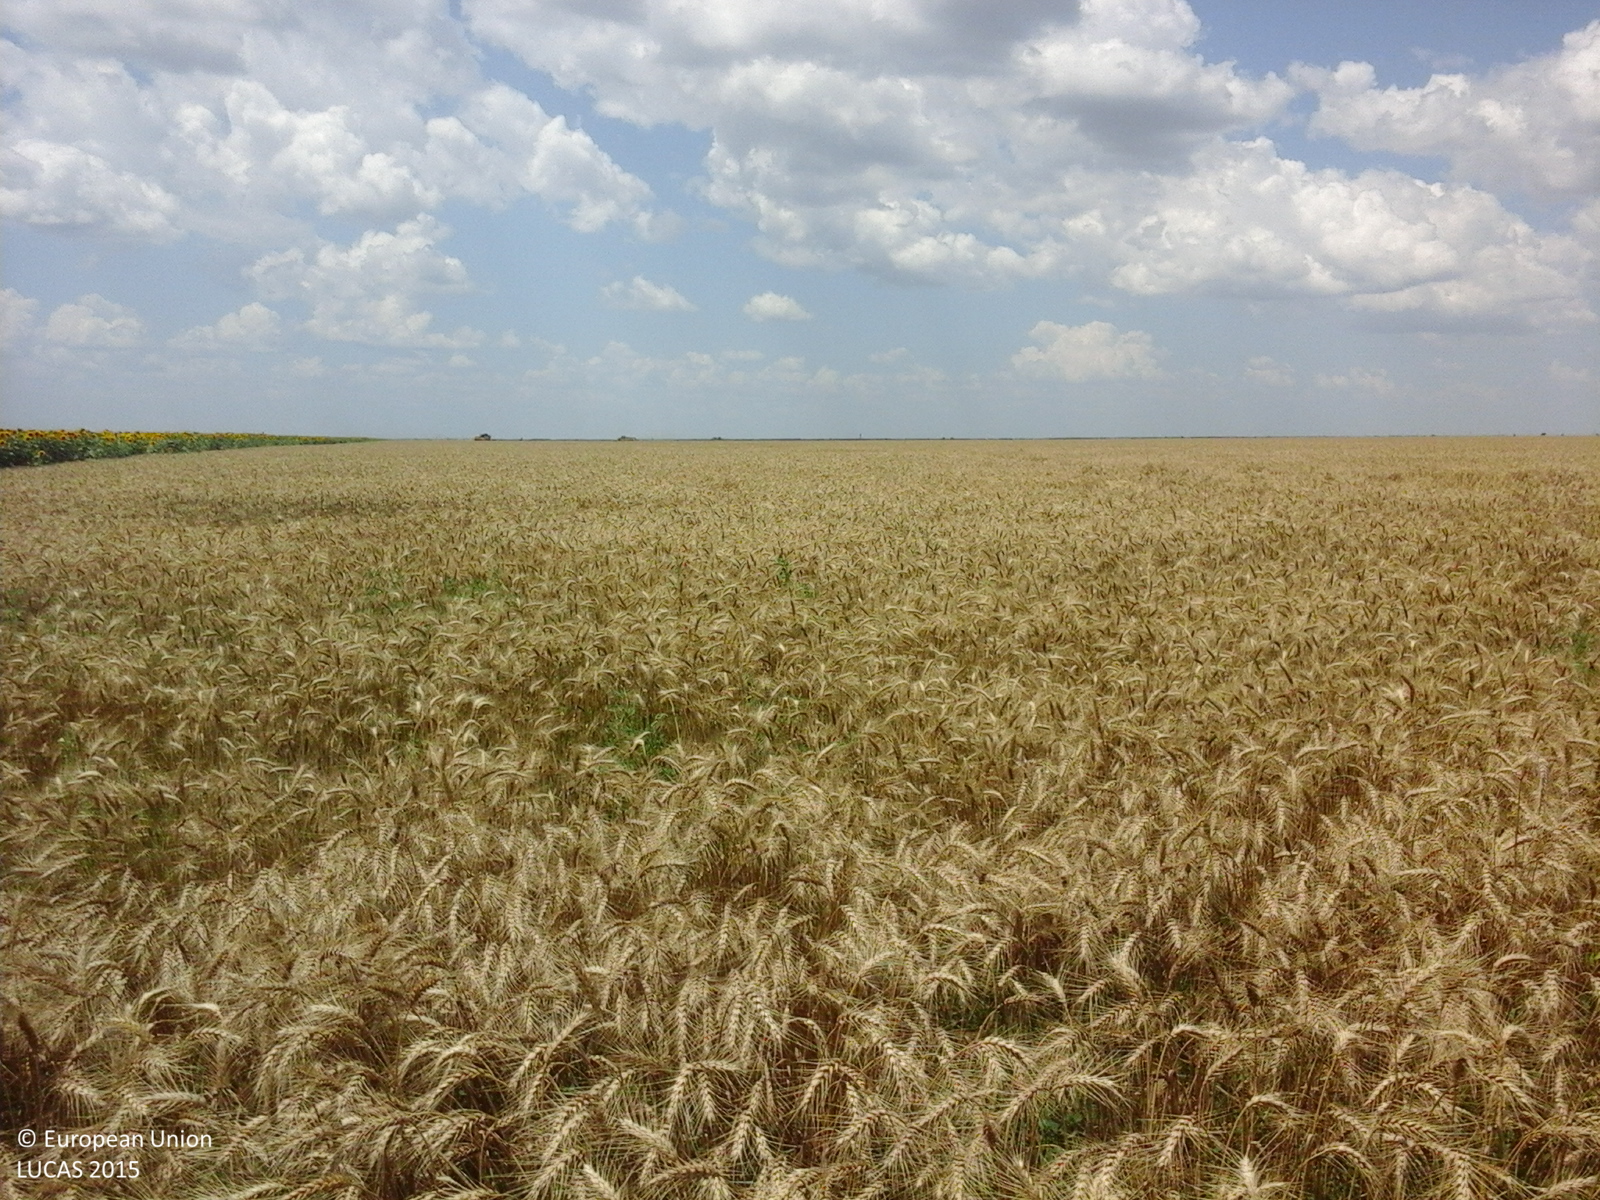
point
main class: Cropland
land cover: Common wheat
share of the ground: > 75 %
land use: Agriculture (excluding fallow land and kitchen gardens)
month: July
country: RO
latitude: 44.0036
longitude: 24.8777
